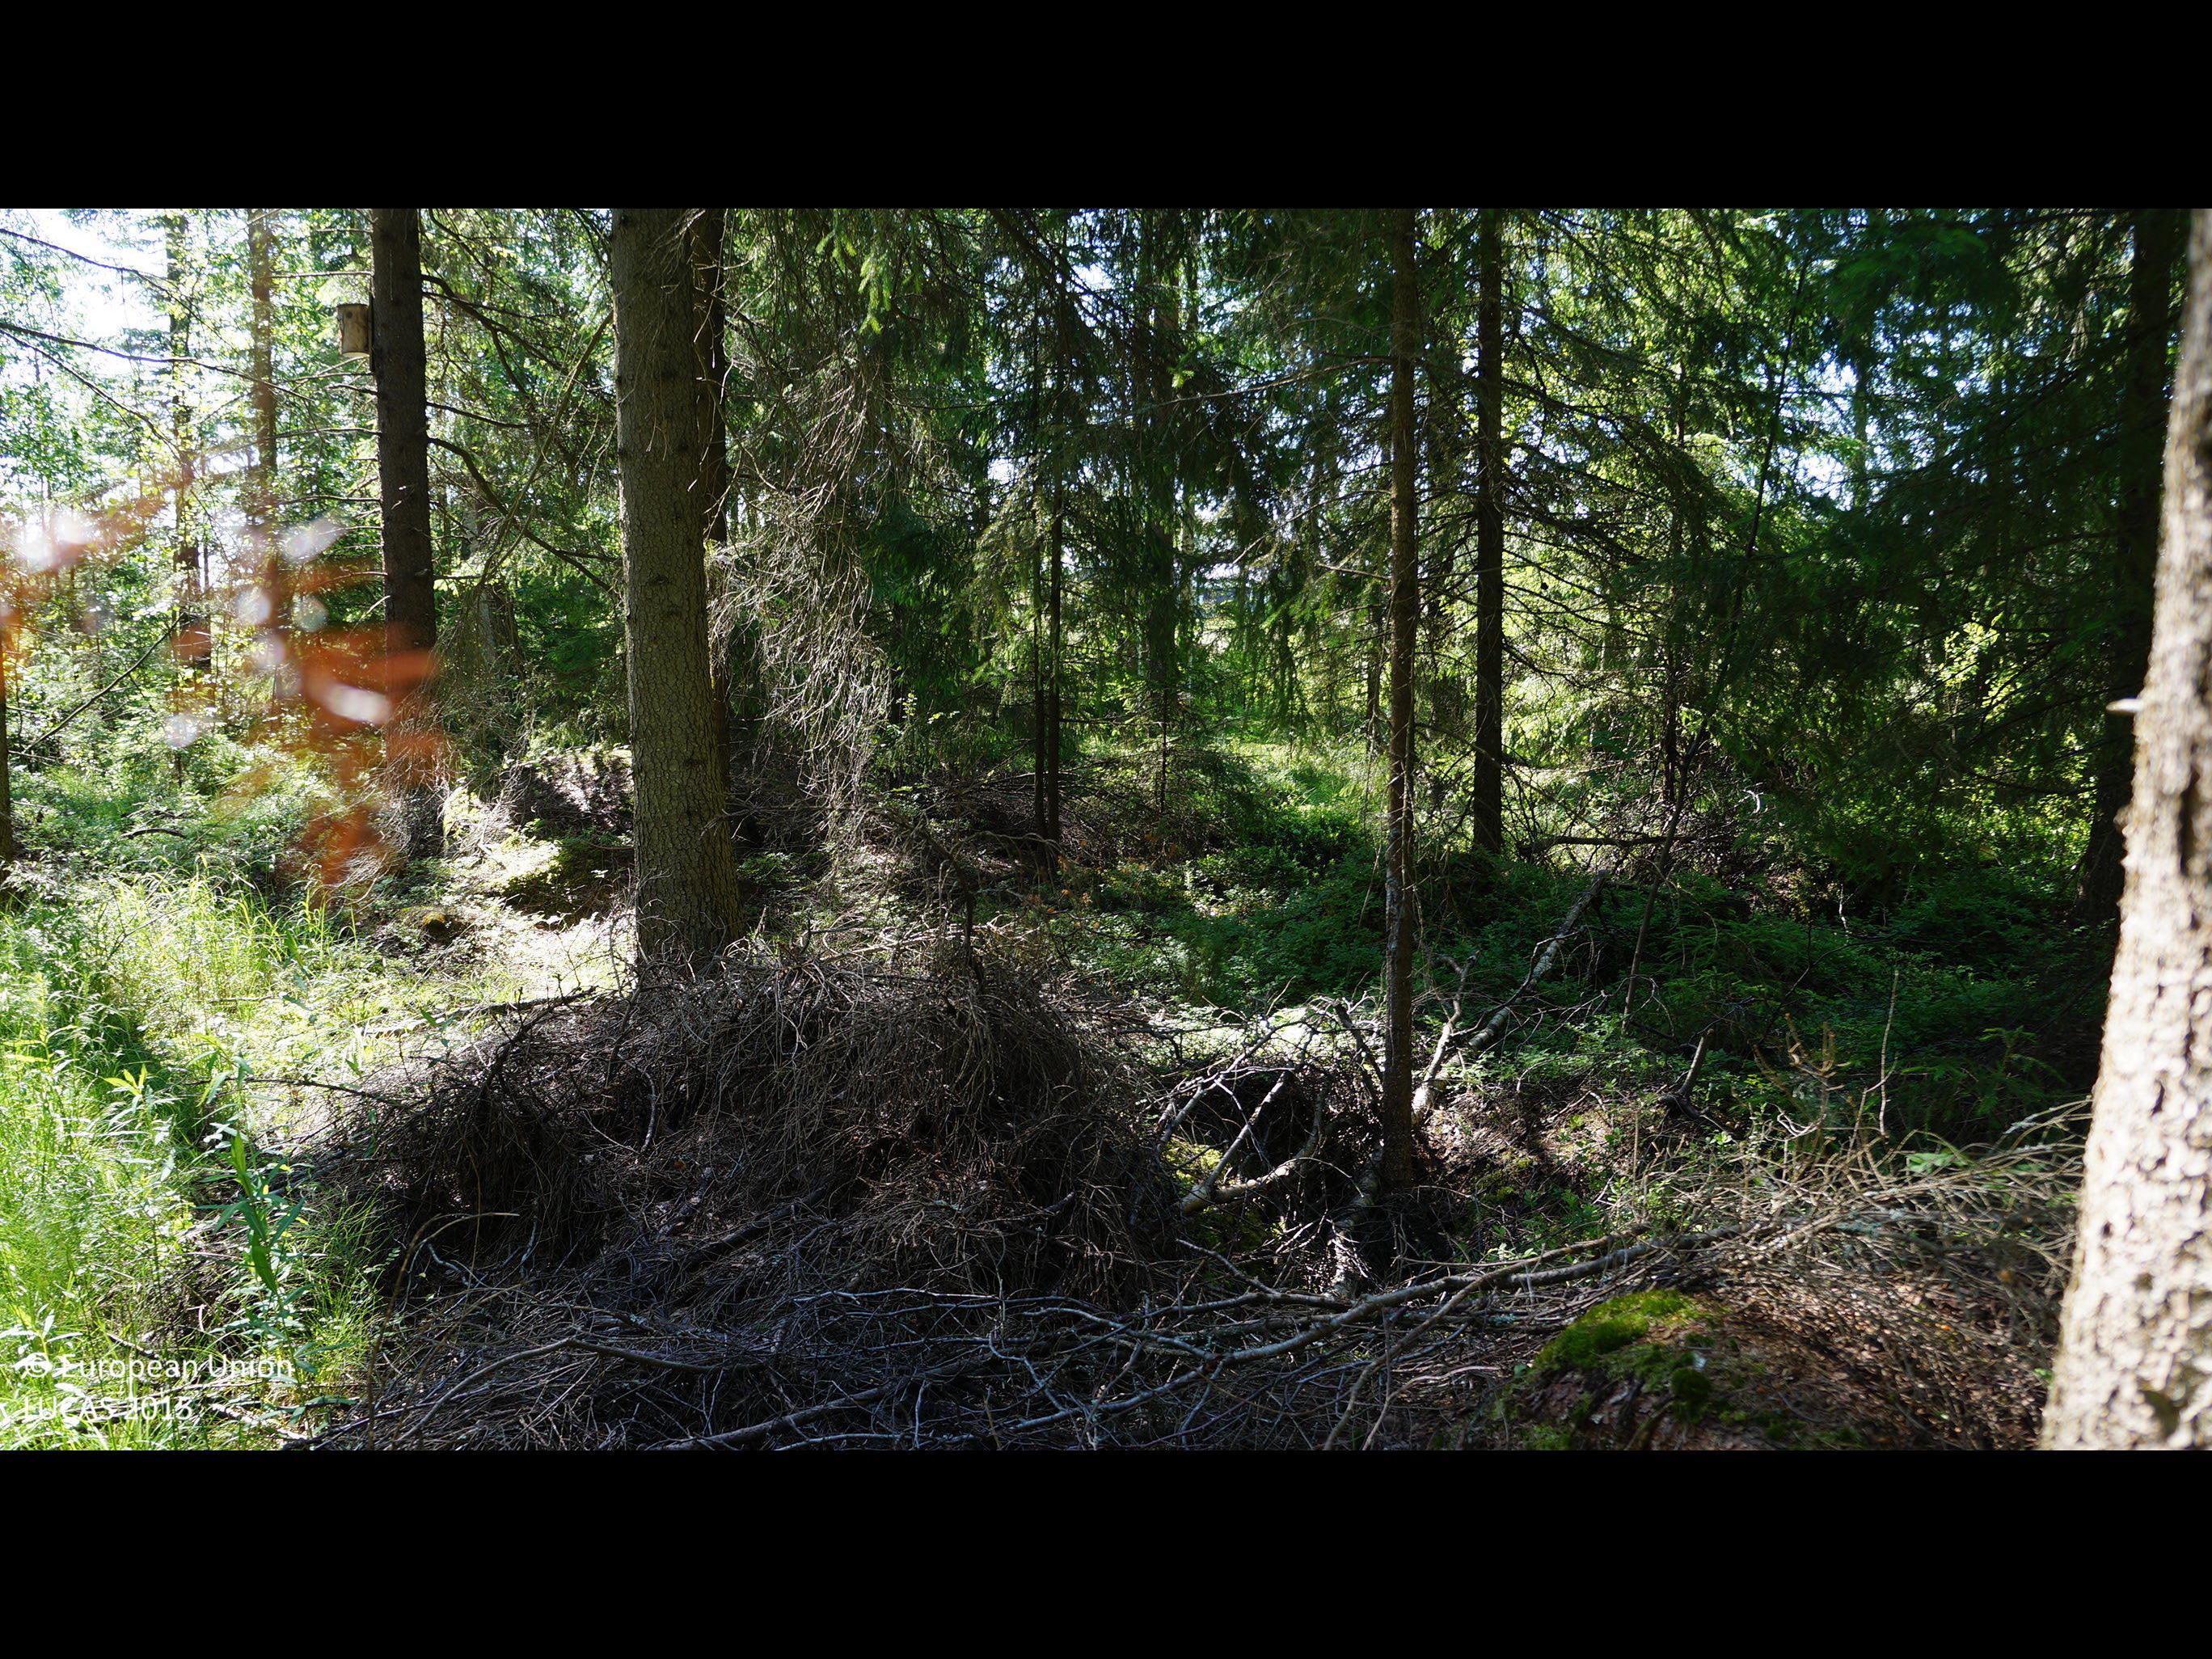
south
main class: Woodland
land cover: Spruce dominated mixed woodland
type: boreal forest
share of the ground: 50 - 75 %
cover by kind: coniferous forest trees 40 %, shrubs 25 %, broadleaved forest trees 20 %, herbaceous plants 15 %
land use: Forestry
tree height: > 5 m
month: July
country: FI
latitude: 63.7959
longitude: 22.8986
